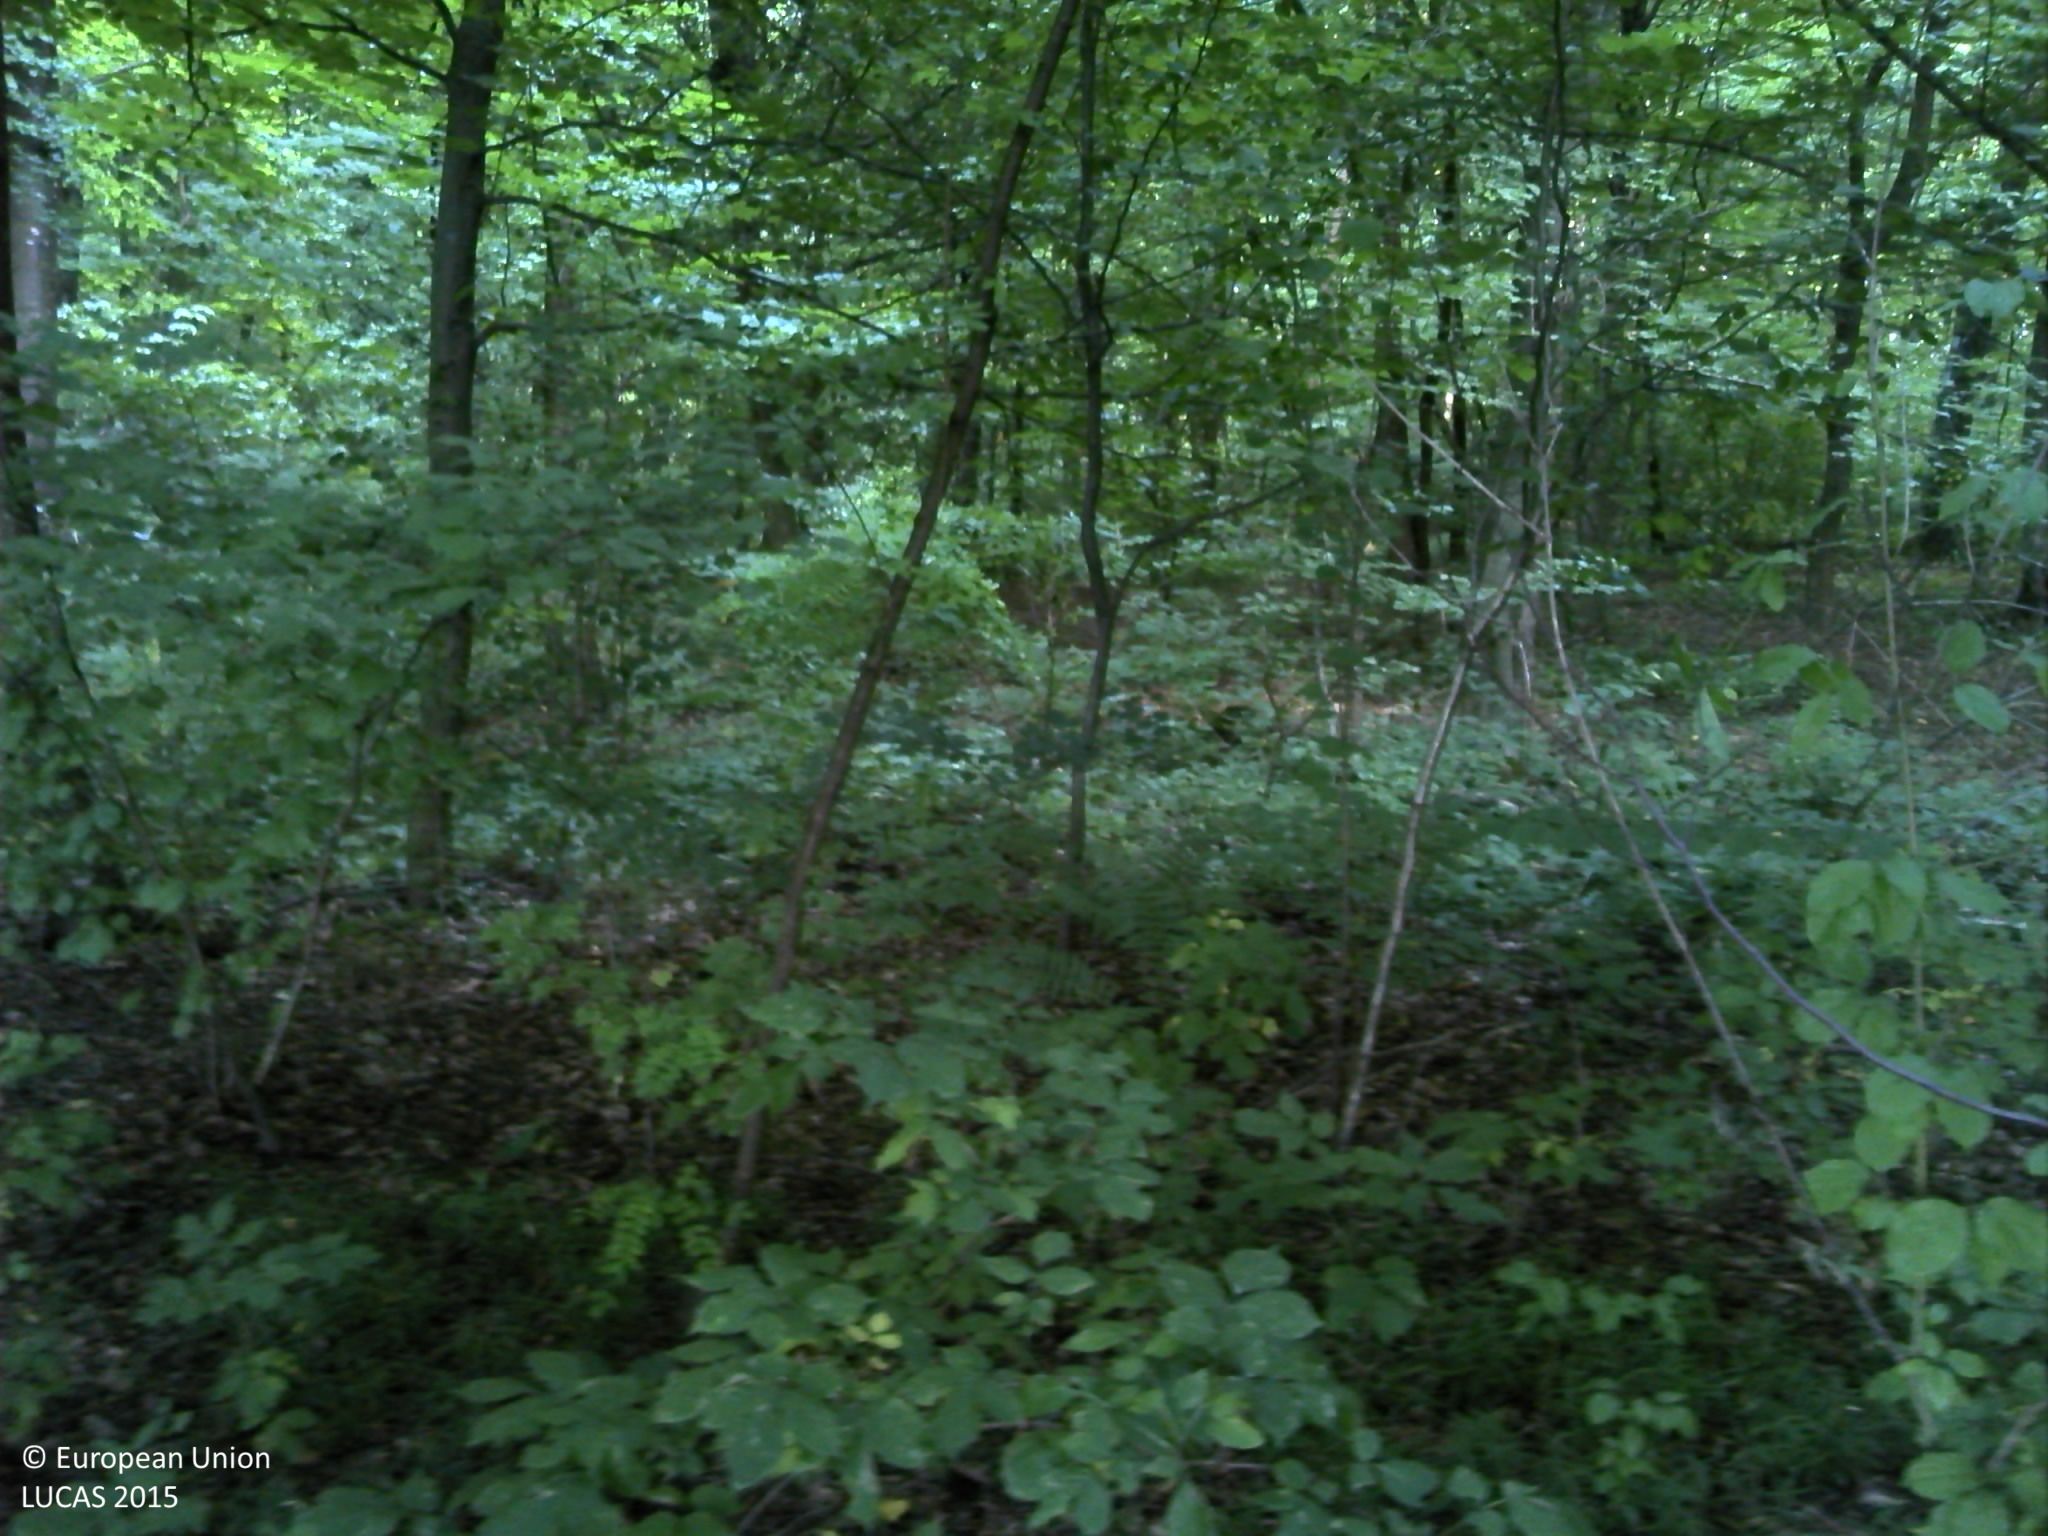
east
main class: Woodland
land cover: Broadleaved woodland
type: beech forest
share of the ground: > 75 %
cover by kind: broadleaved forest trees 100 %
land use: Forestry
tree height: > 5 m
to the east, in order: Broadleaved woodland
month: August
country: HR
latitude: 45.5453
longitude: 17.2371
